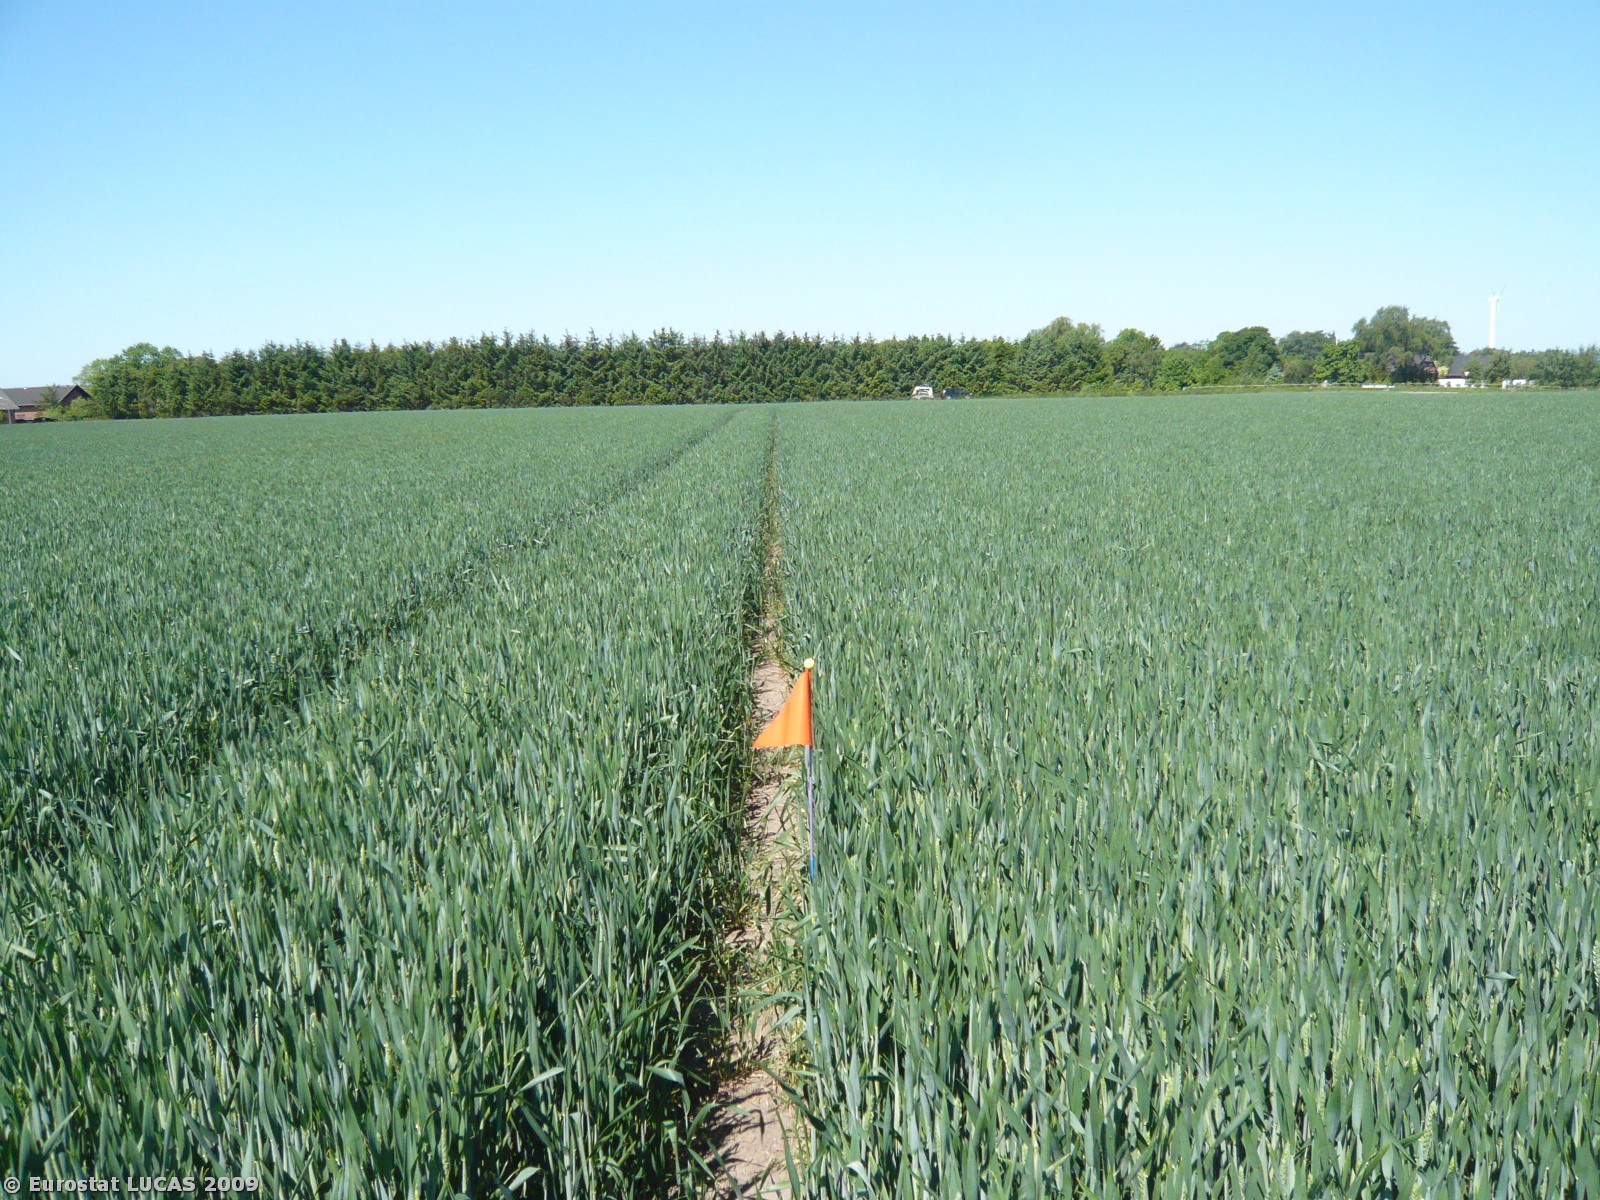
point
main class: Cropland
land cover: Common wheat
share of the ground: > 75 %
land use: Agriculture (excluding fallow land and kitchen gardens)
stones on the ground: < 10 %
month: June
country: DK
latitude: 55.6664
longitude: 12.1444
